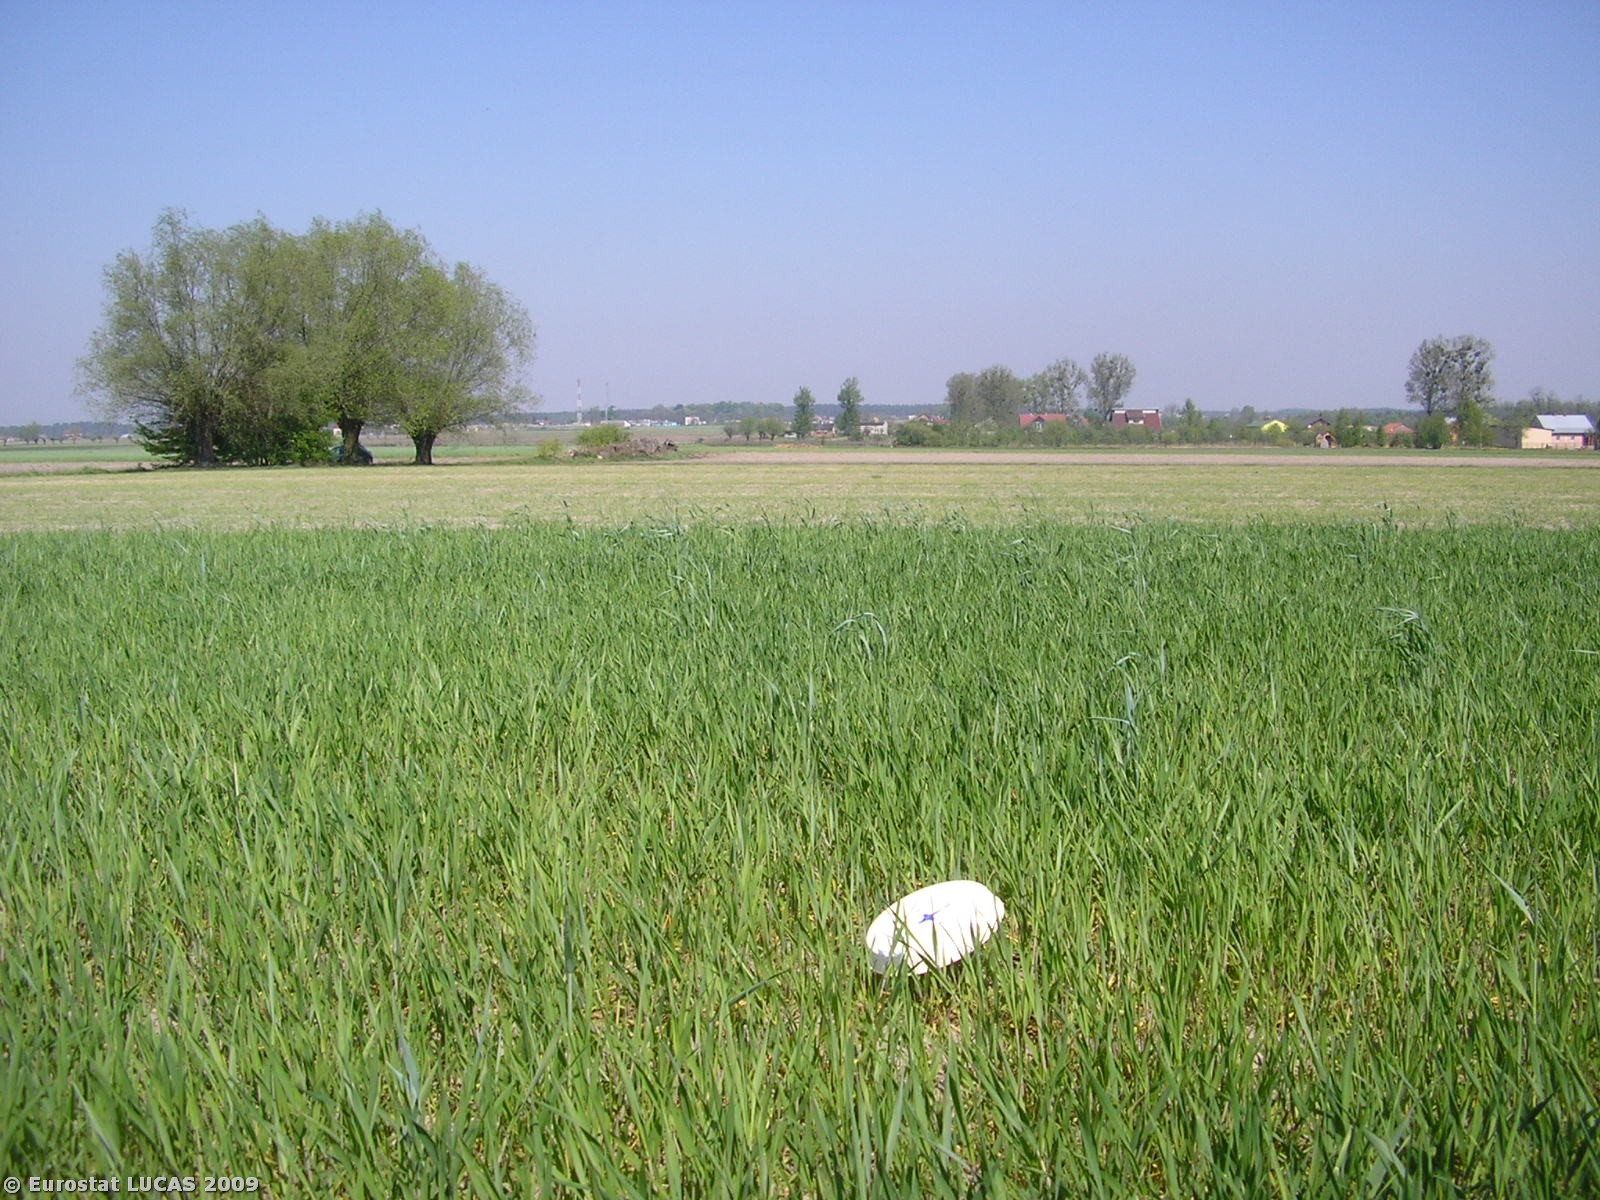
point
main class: Cropland
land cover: Triticale
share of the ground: 50 - 75 %
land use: Agriculture (excluding fallow land and kitchen gardens)
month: April
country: PL
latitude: 52.2820
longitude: 20.1929
